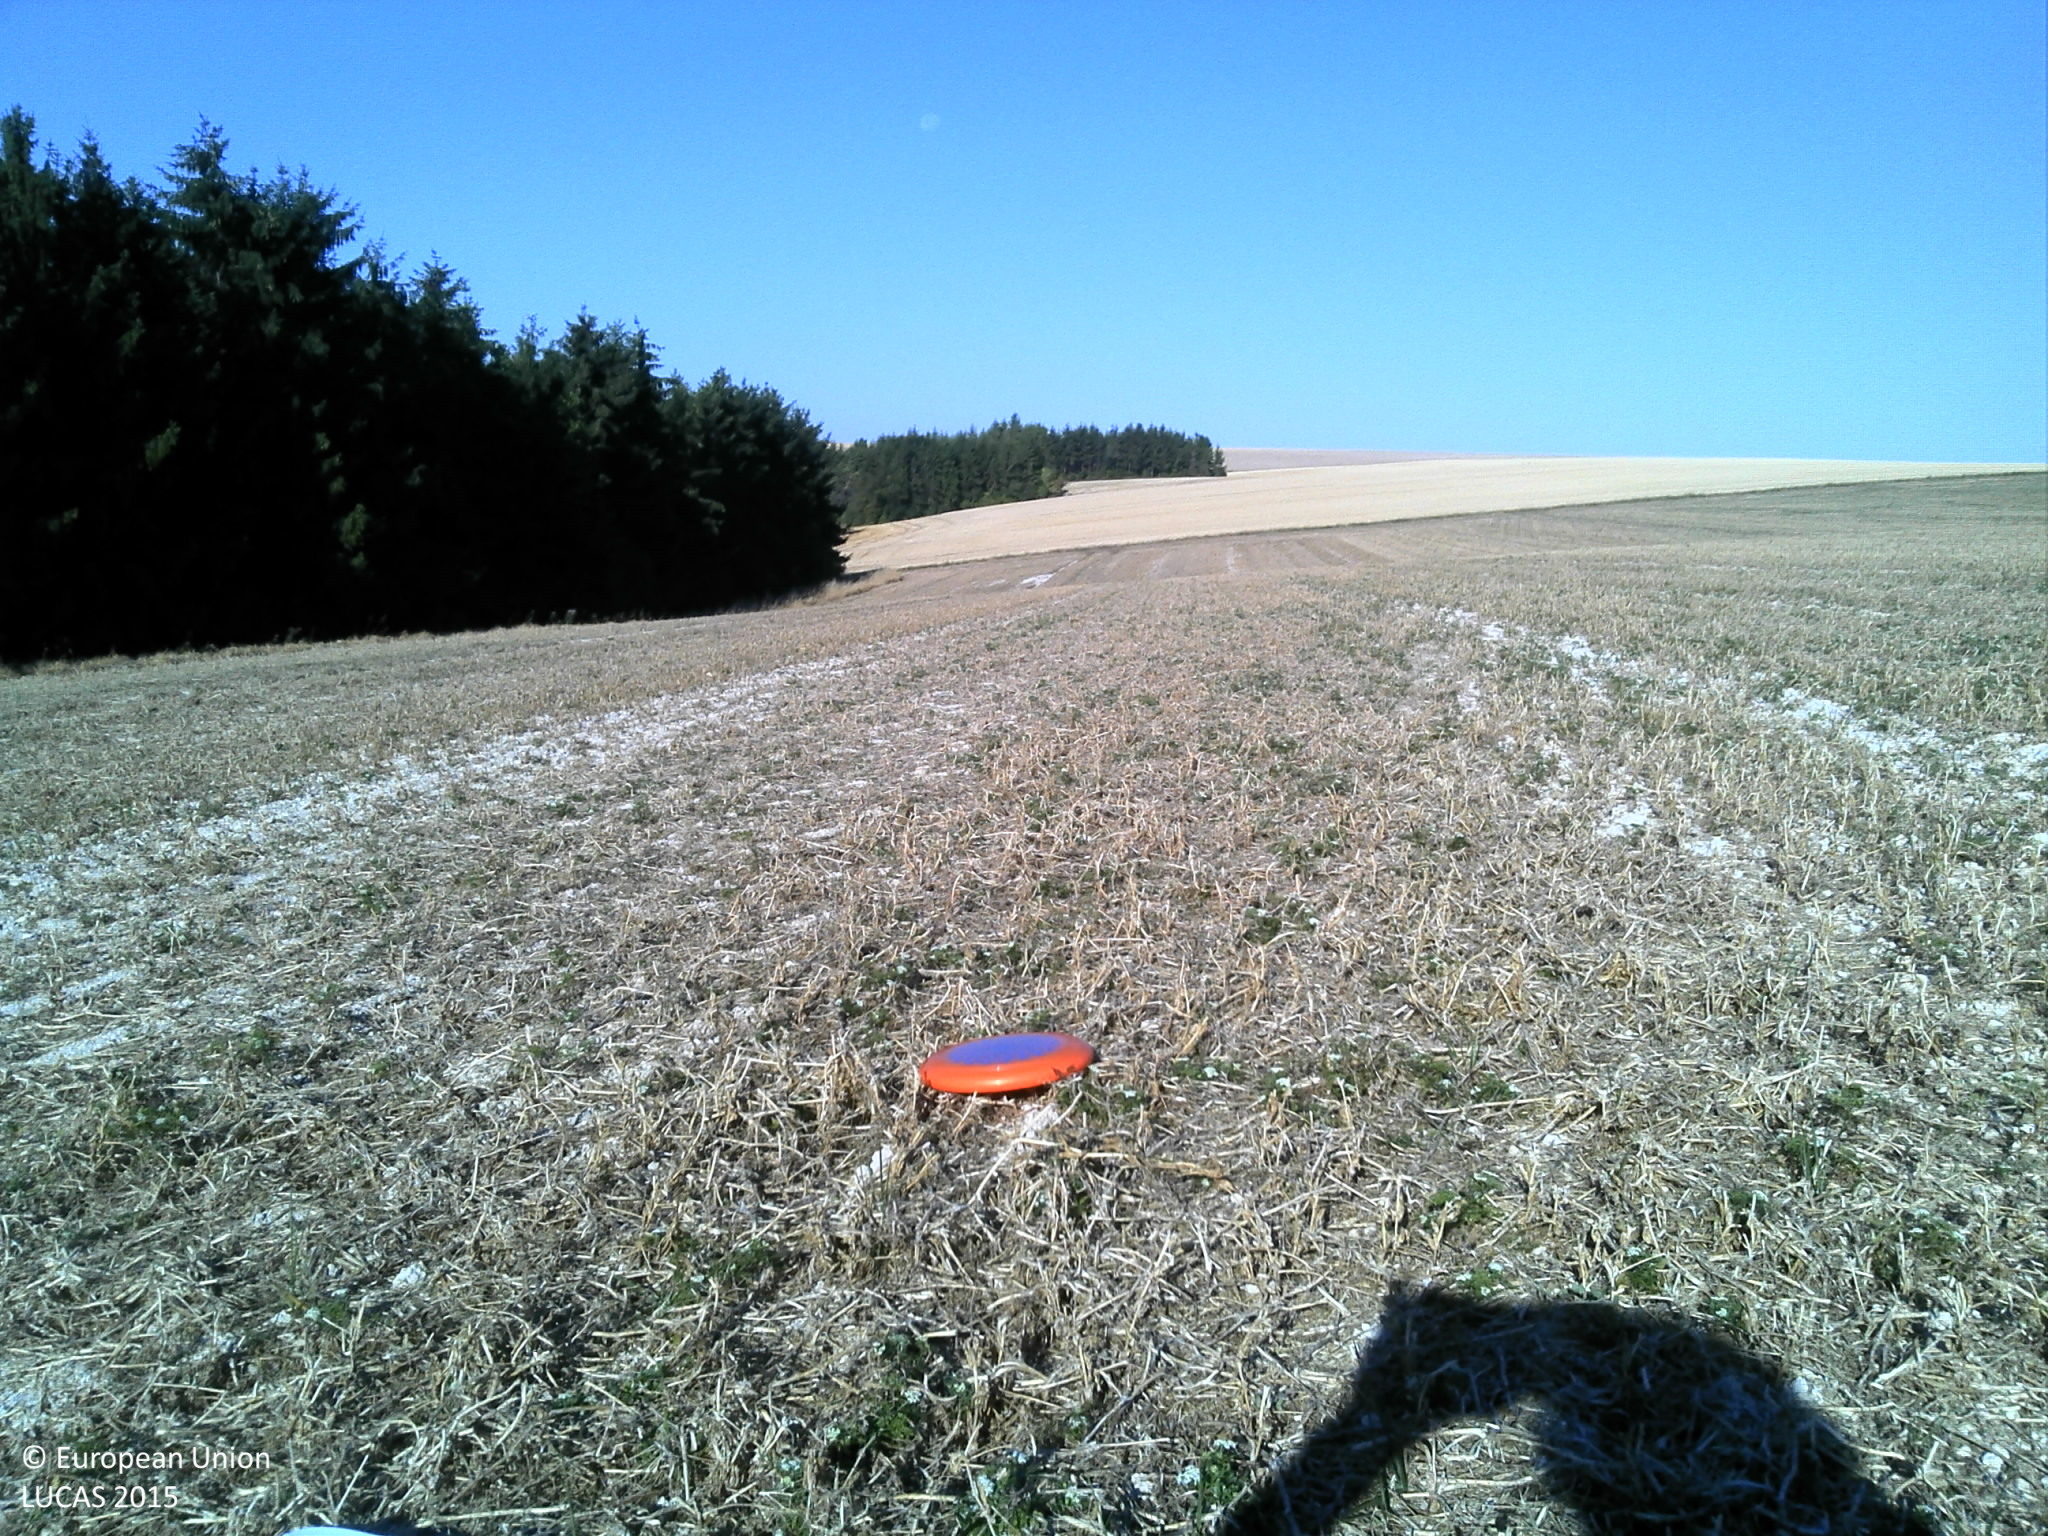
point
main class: Cropland
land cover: Dry pulses
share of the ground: > 75 %
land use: Agriculture (excluding fallow land and kitchen gardens)
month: August
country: FR
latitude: 49.1261
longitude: 4.7487
